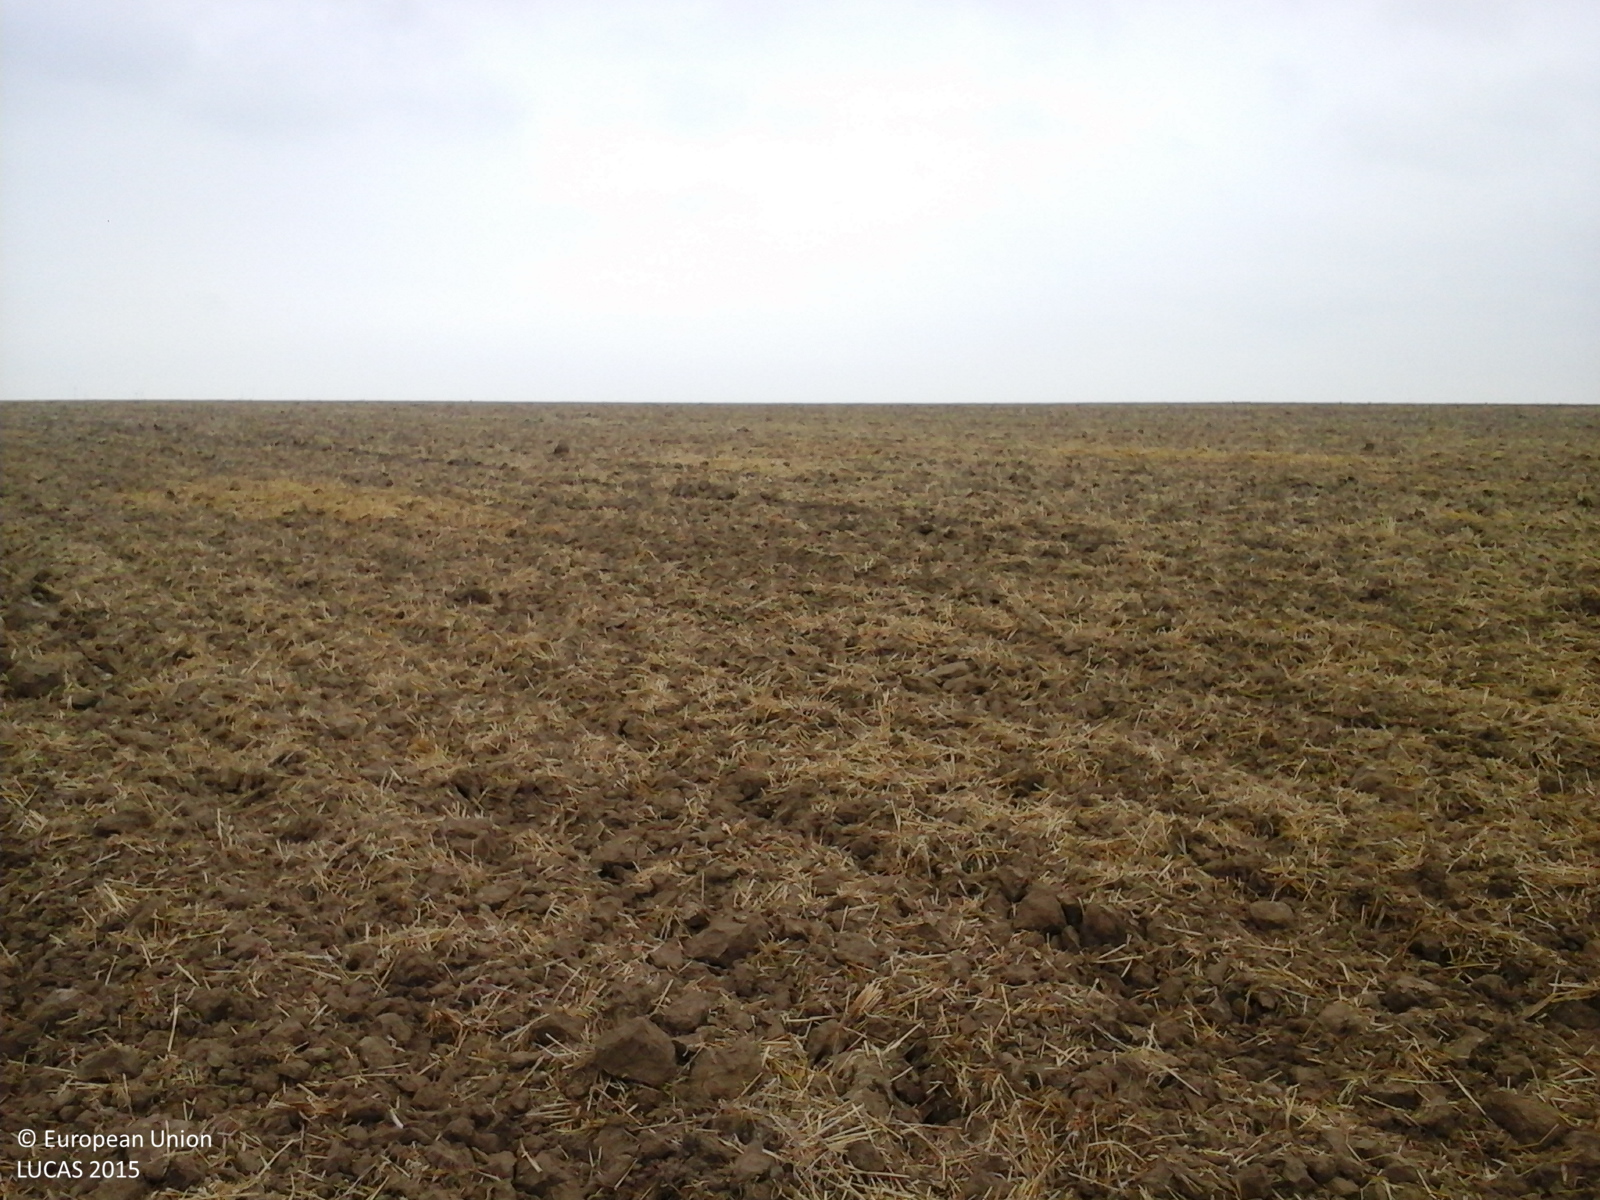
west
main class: Cropland
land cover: Common wheat
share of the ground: < 10 %
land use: Agriculture (excluding fallow land and kitchen gardens)
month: August
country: RO
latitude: 44.8249
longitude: 28.3208
